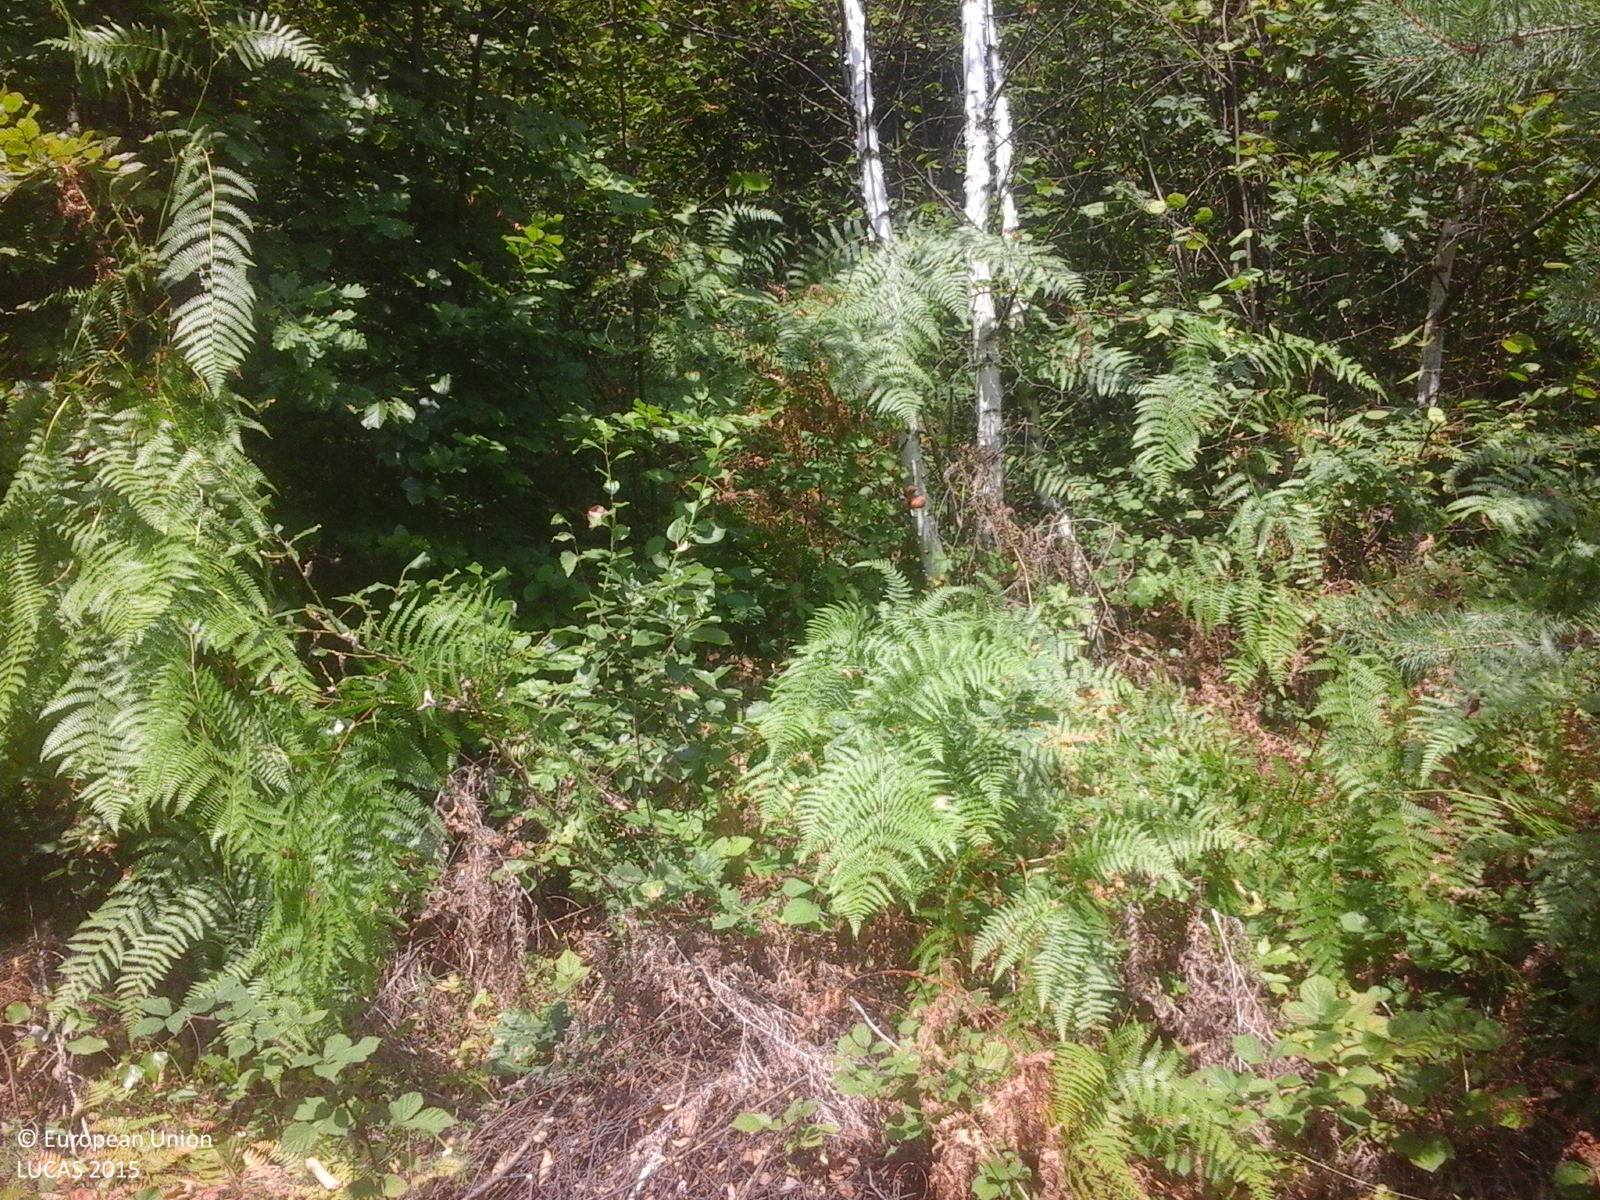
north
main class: Woodland
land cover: Broadleaved woodland
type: mesophytic deciduous forest
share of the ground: > 75 %
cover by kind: broadleaved forest trees 100 %
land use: Forestry
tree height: > 5 m
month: August
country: RO
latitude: 46.4068
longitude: 22.5789
